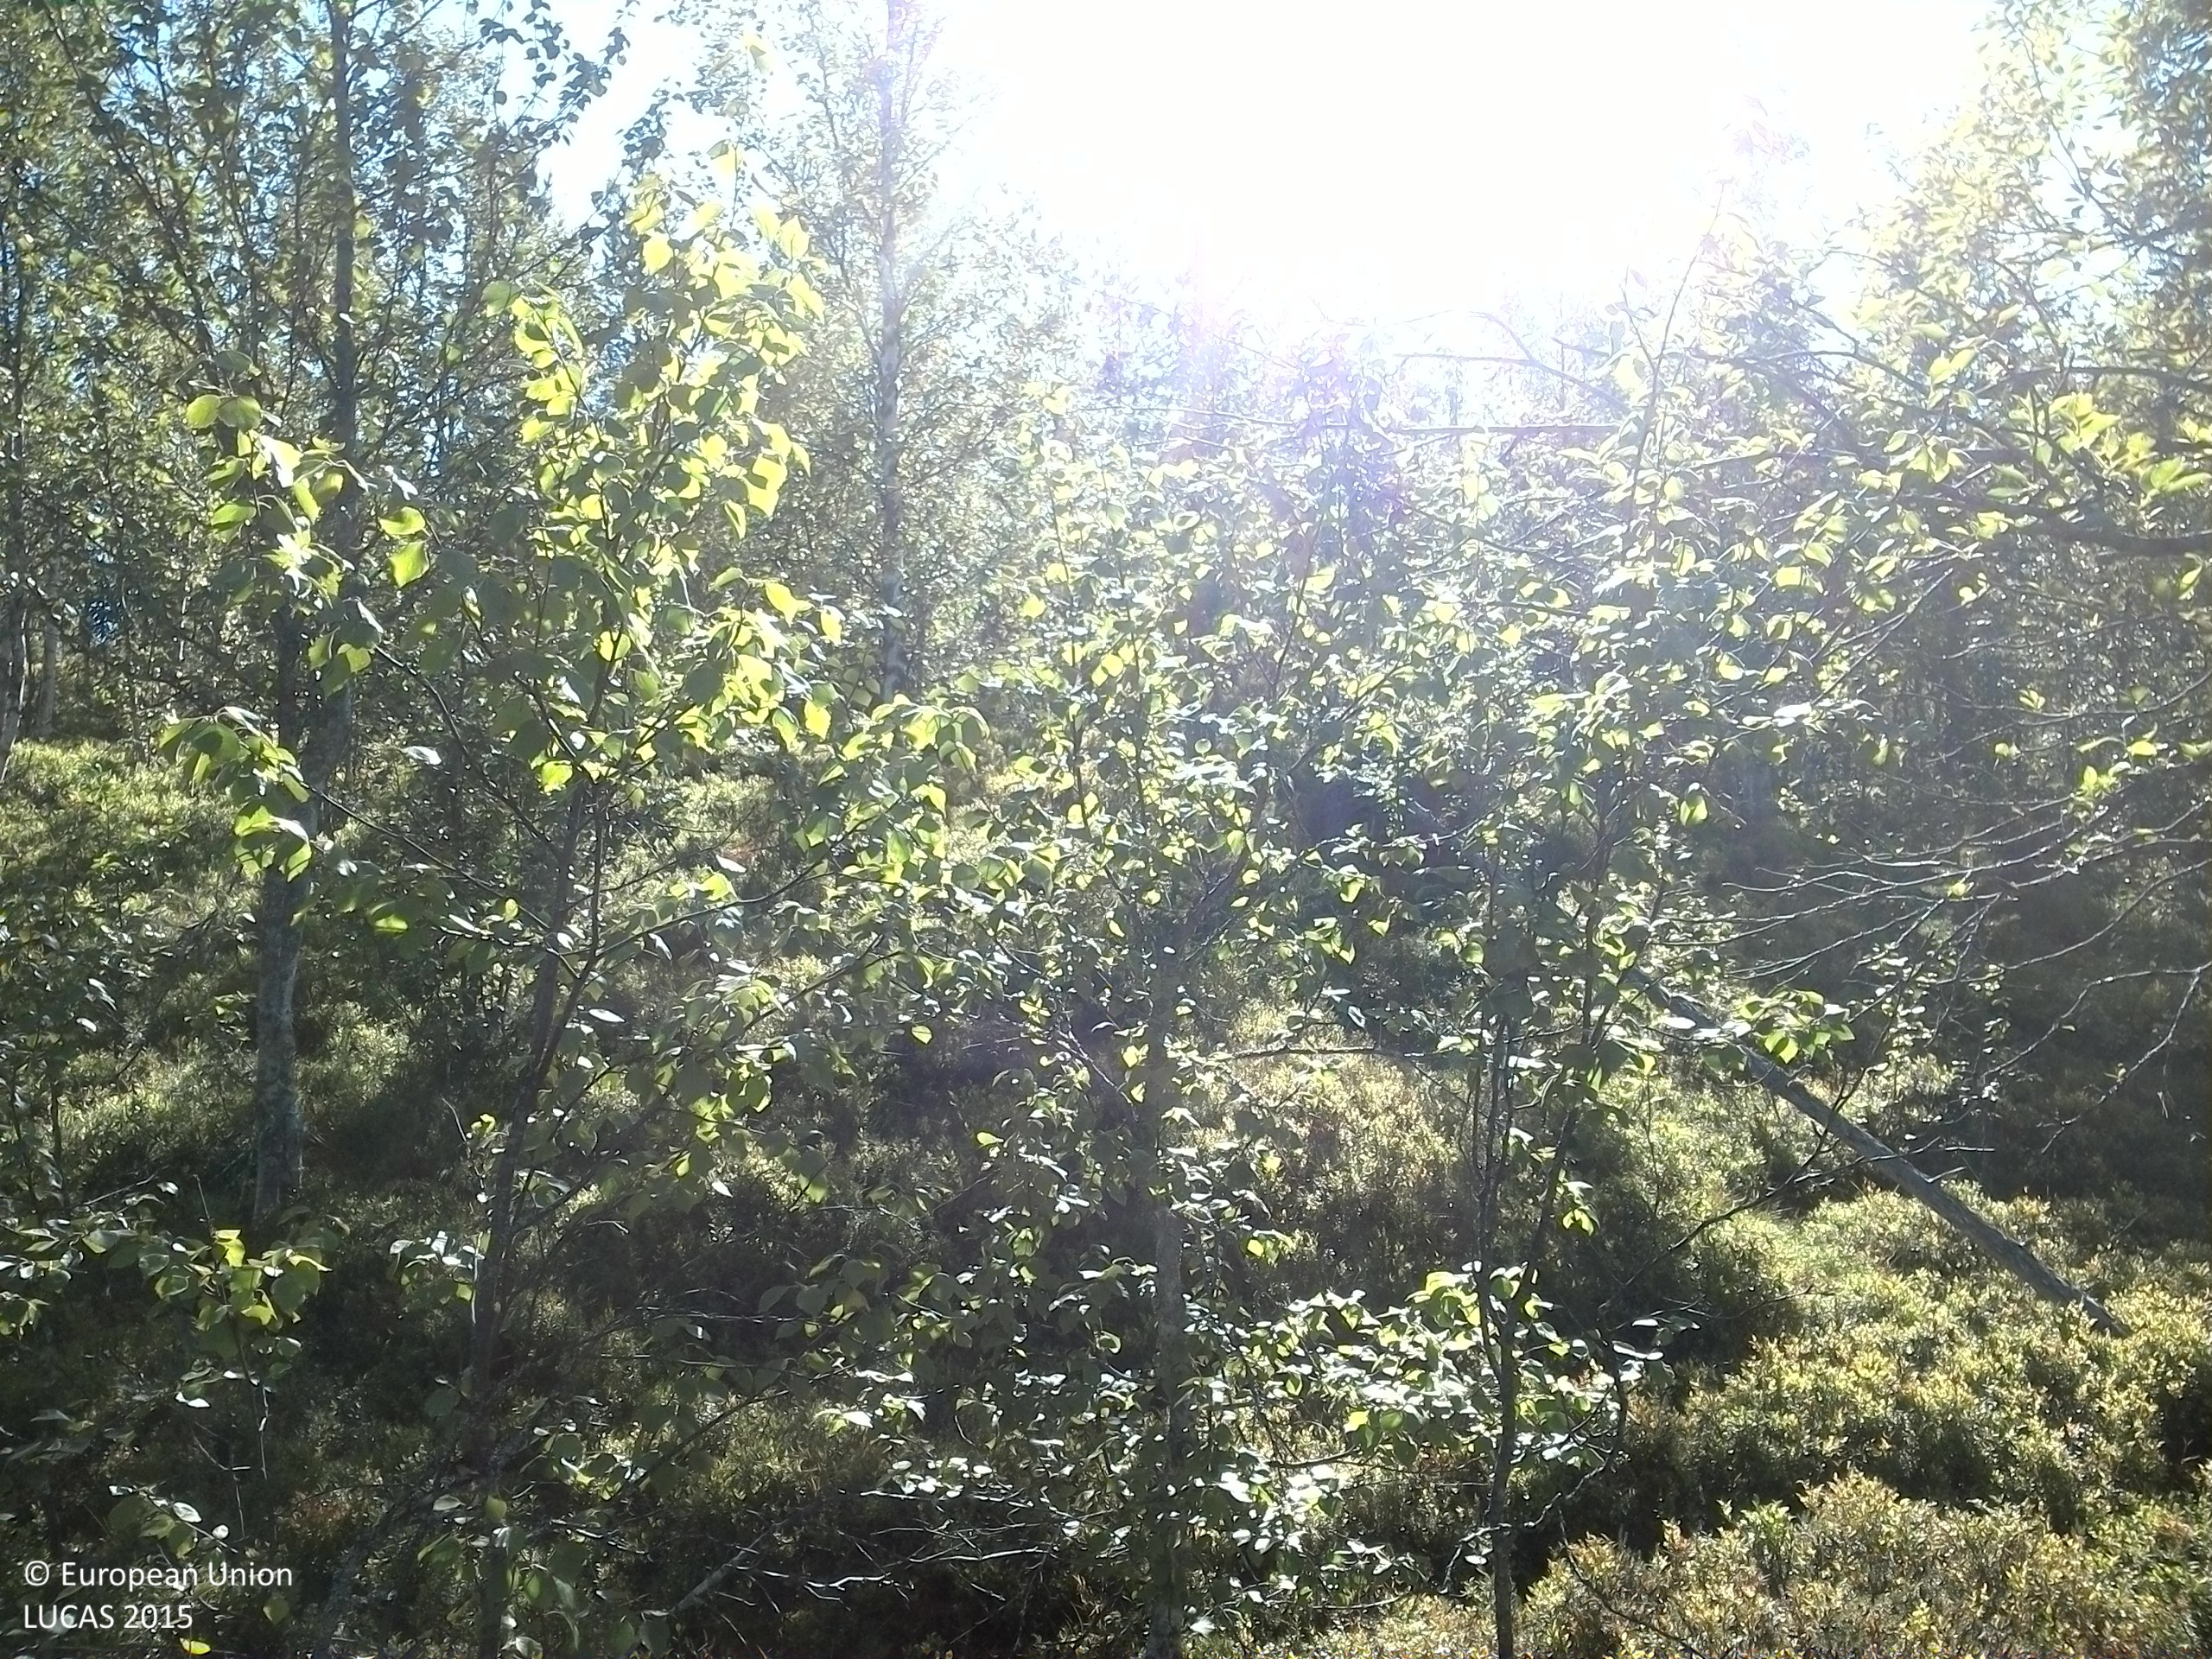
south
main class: Woodland
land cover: Broadleaved woodland
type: boreal forest
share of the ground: 25 - 50 %
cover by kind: shrubs 50 %, broadleaved forest trees 40 %, coniferous forest trees 5 %, lichens and mosses 5 %
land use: Forestry
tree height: < 5 m
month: August
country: SE
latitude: 63.8810
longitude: 17.7693
